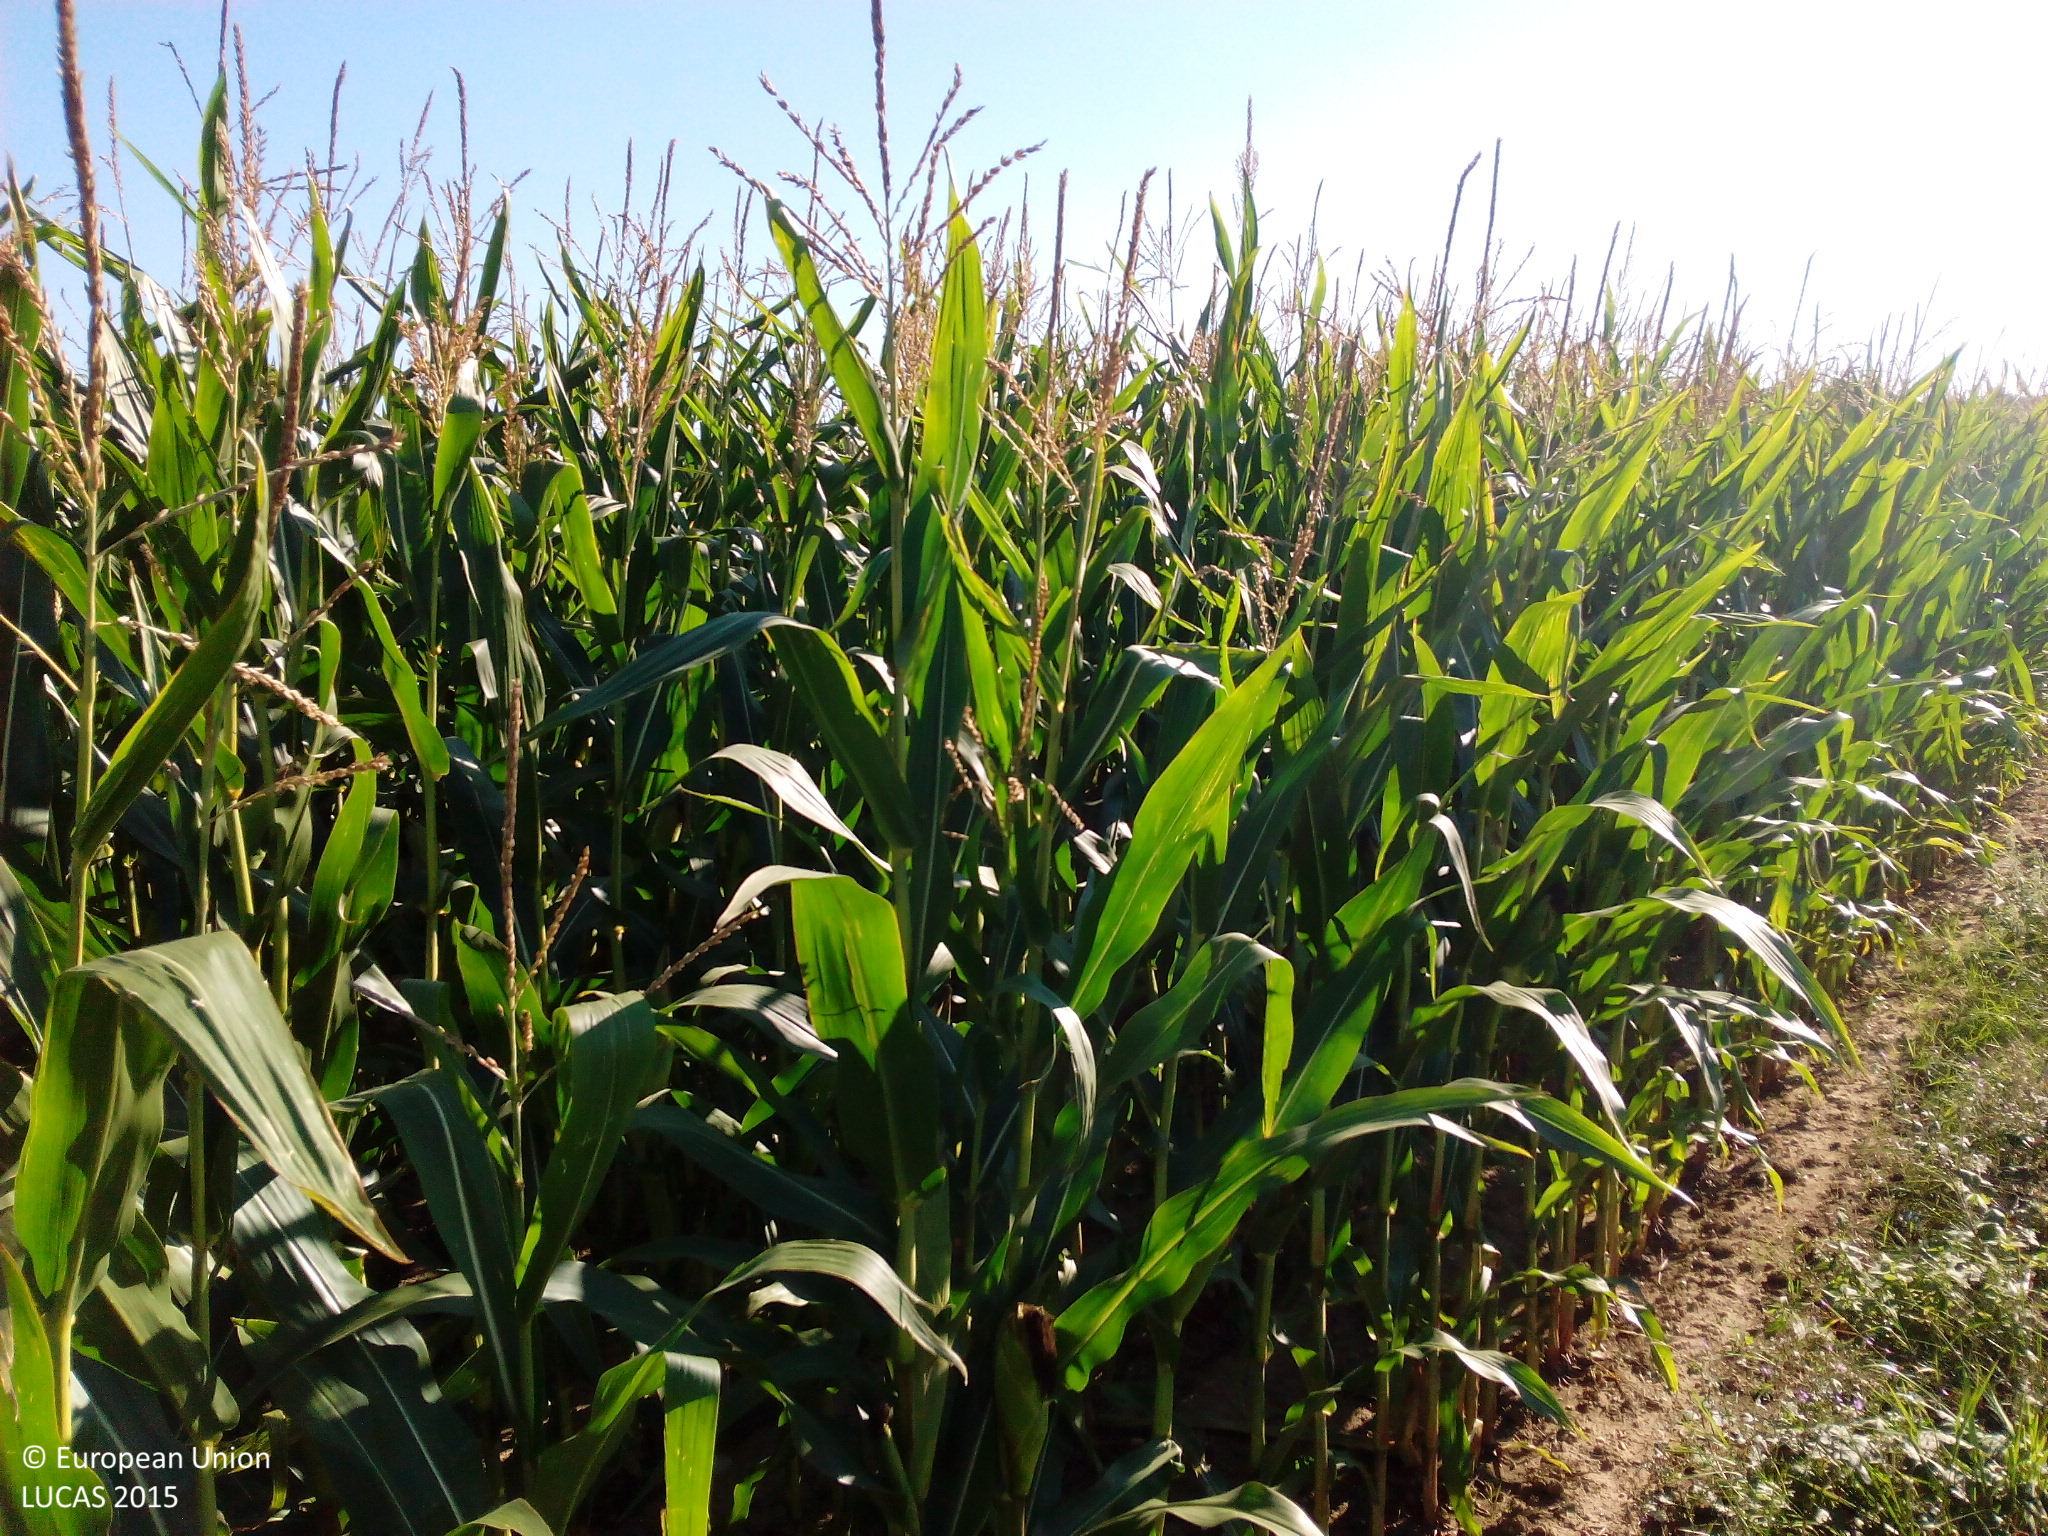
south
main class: Cropland
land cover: Maize
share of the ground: > 75 %
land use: Agriculture (excluding fallow land and kitchen gardens)
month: August
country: DE
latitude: 48.3315
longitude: 9.9596
